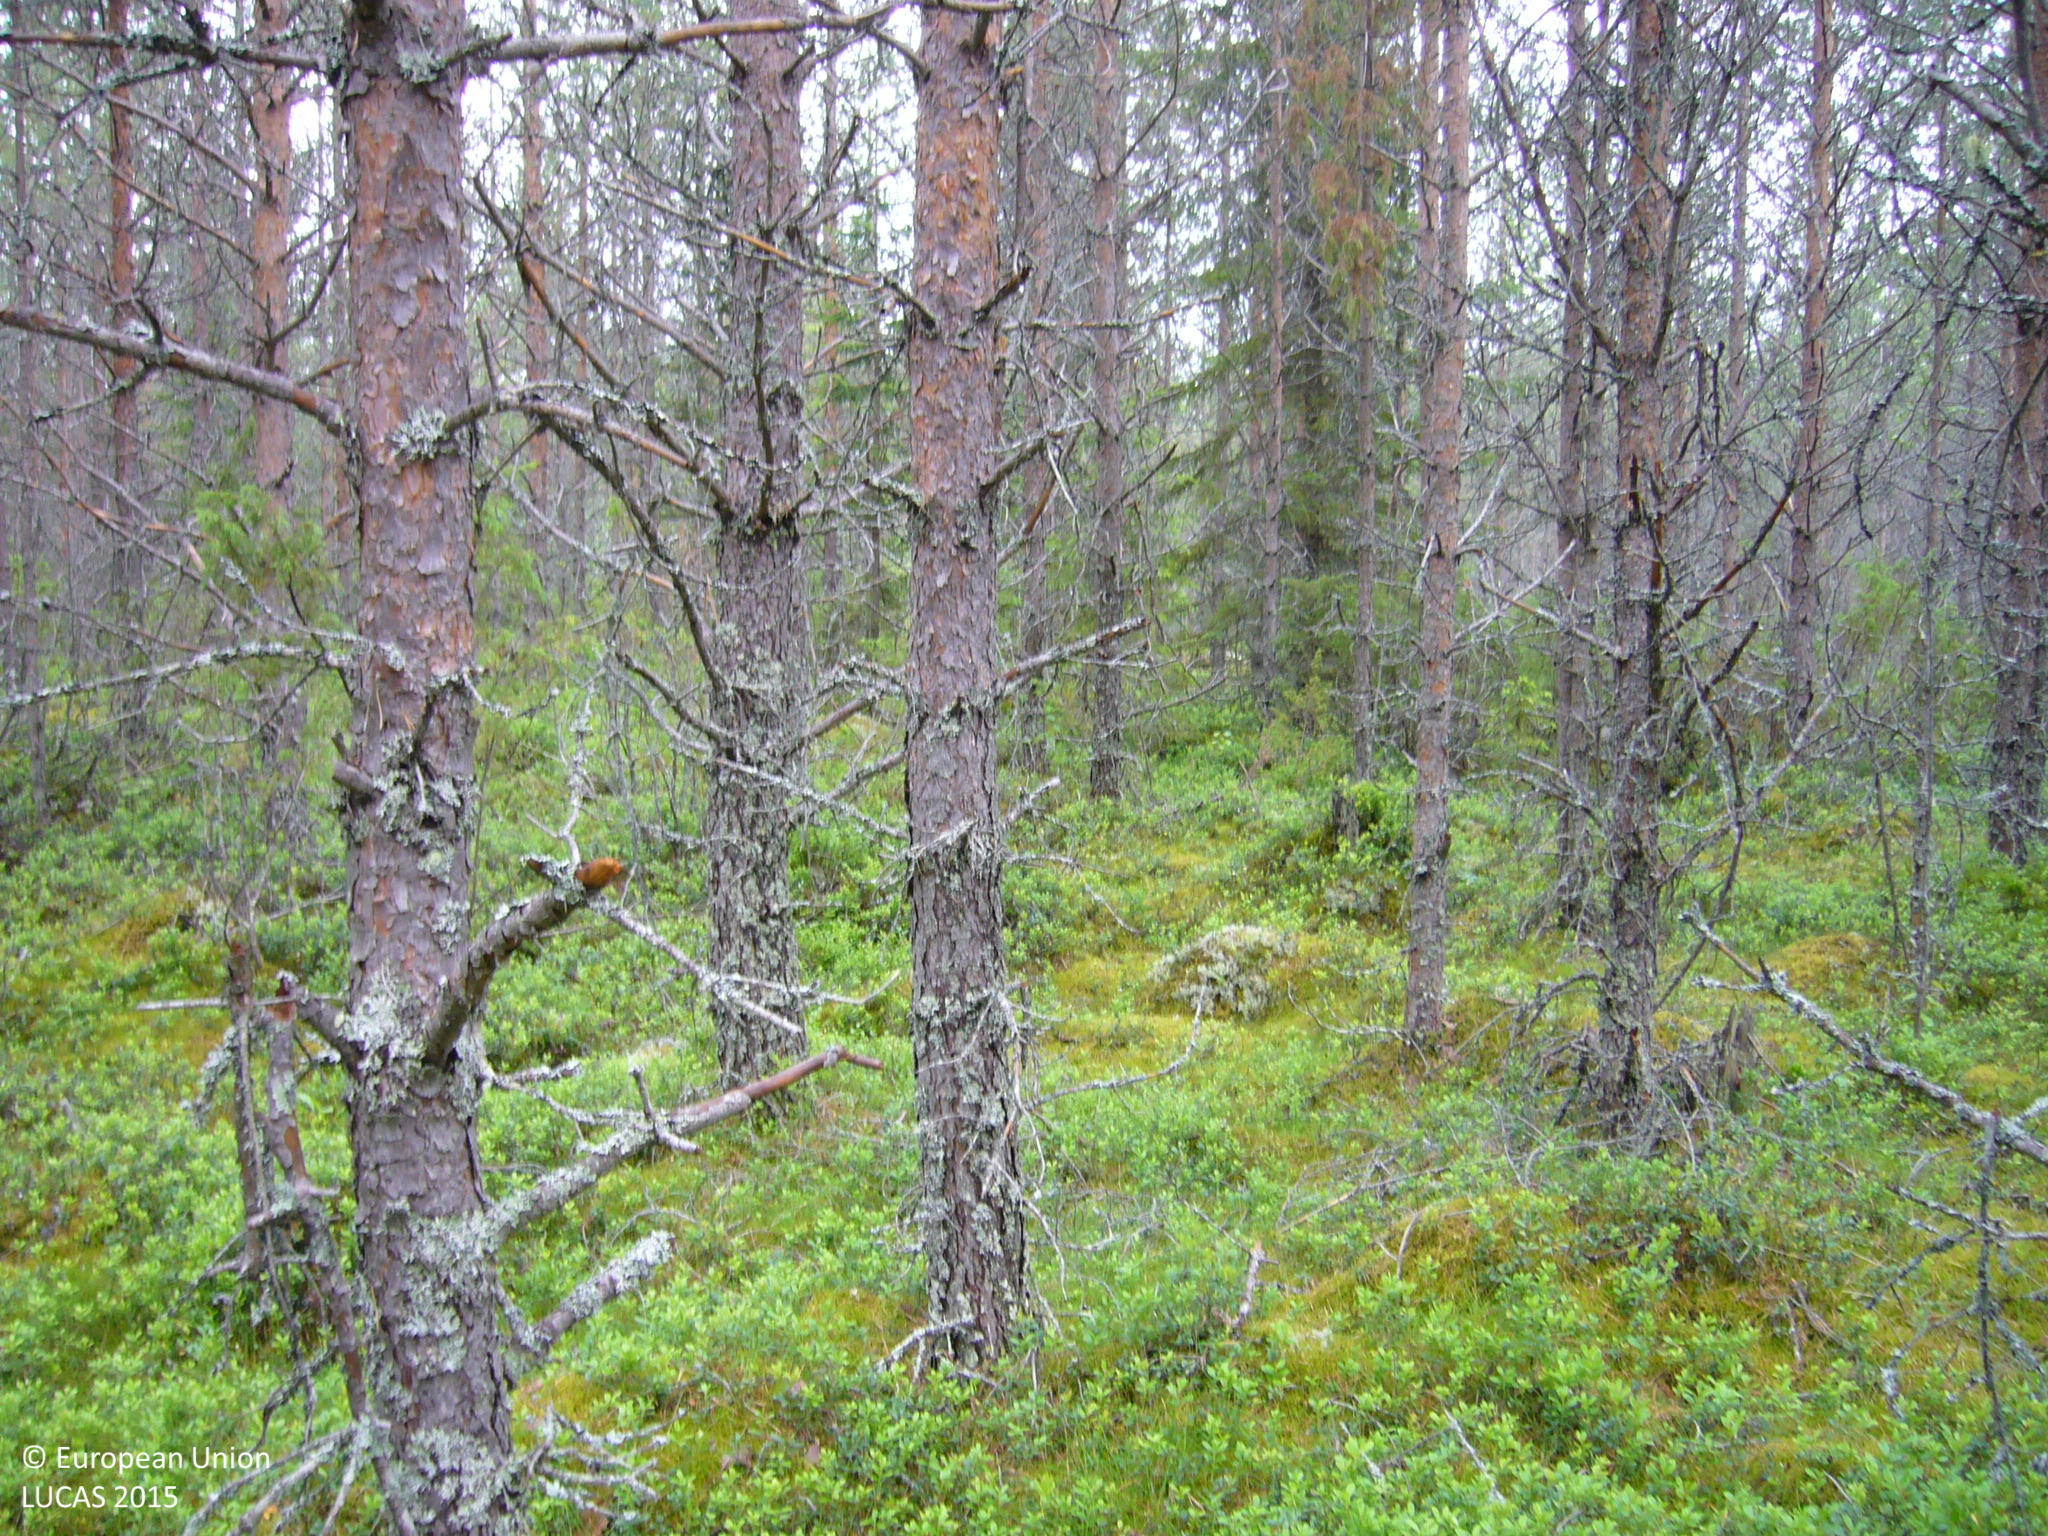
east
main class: Woodland
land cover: Pine dominated coniferous woodland
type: boreal forest
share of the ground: > 75 %
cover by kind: coniferous forest trees 75 %, shrubs 25 %
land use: Forestry
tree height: > 5 m
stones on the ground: > 50 %
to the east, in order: Pine dominated coniferous woodland; Ditches and canals; Shruby margins; Paved roads, cycling and walking lanes
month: July
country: FI
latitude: 63.6029
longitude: 25.3997
